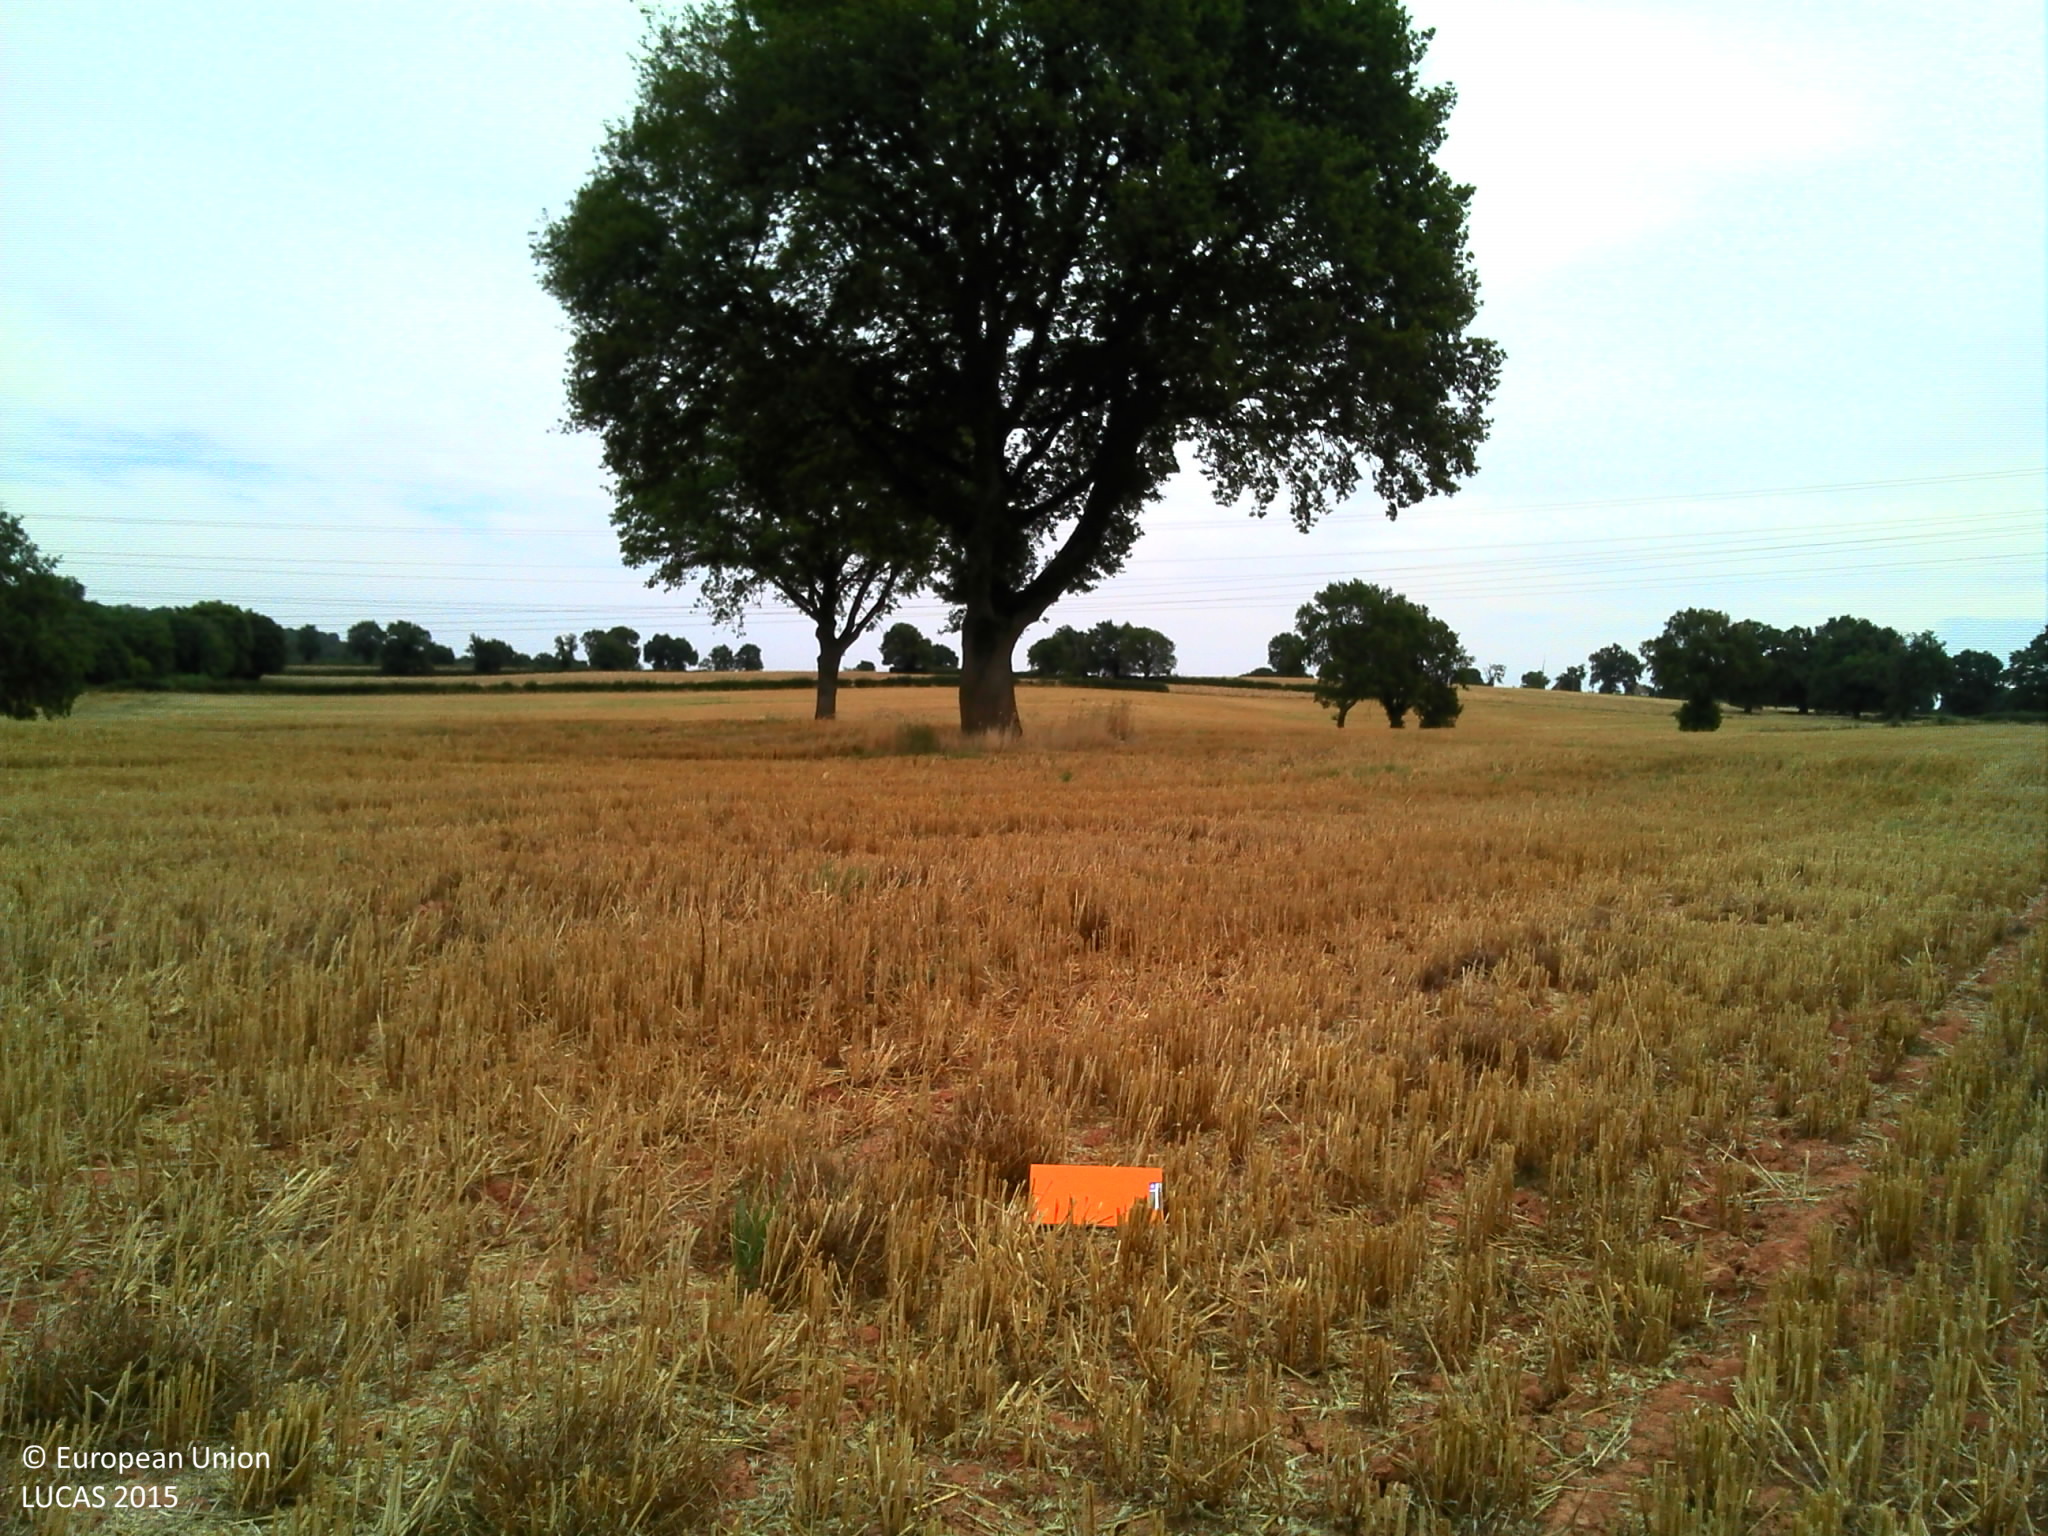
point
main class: Cropland
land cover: Common wheat
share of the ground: > 75 %
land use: Agriculture (excluding fallow land and kitchen gardens)
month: July
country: FR
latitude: 46.5730
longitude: 2.9903
